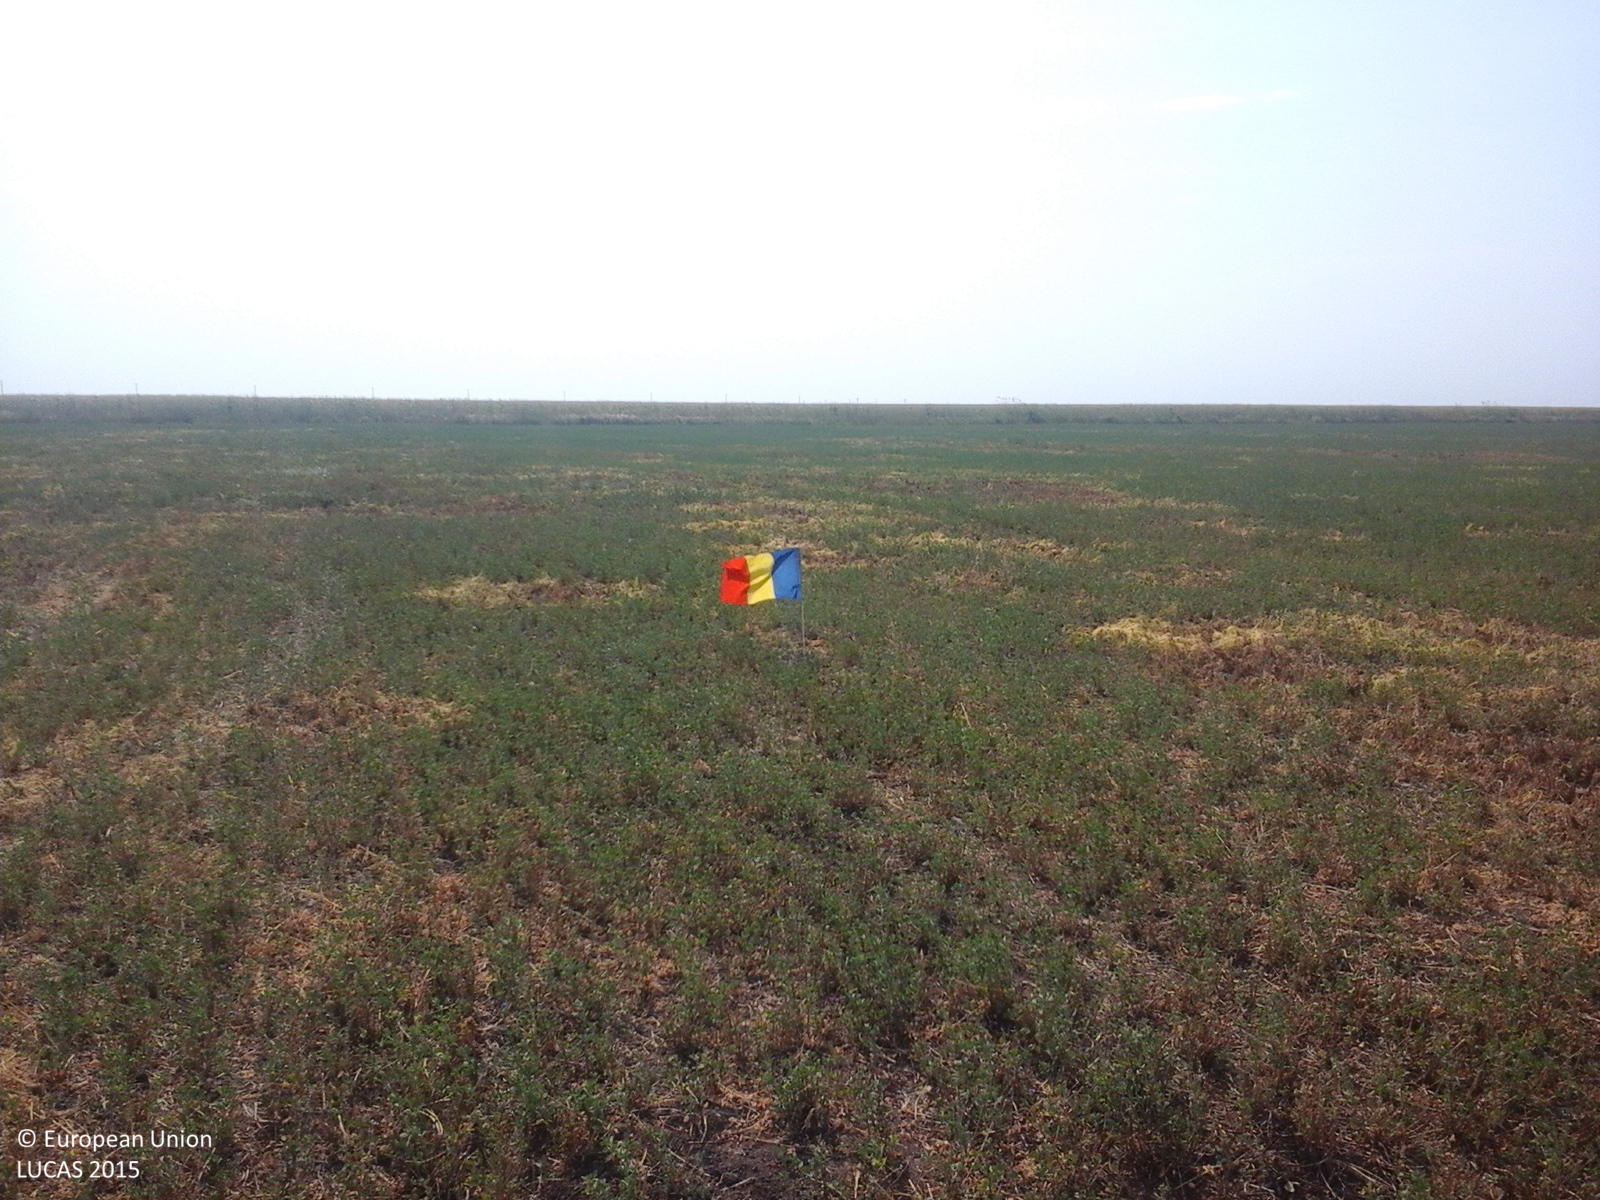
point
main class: Cropland
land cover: Lucerne
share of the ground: > 75 %
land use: Agriculture (excluding fallow land and kitchen gardens)
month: August
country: RO
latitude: 45.0226
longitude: 27.3924
